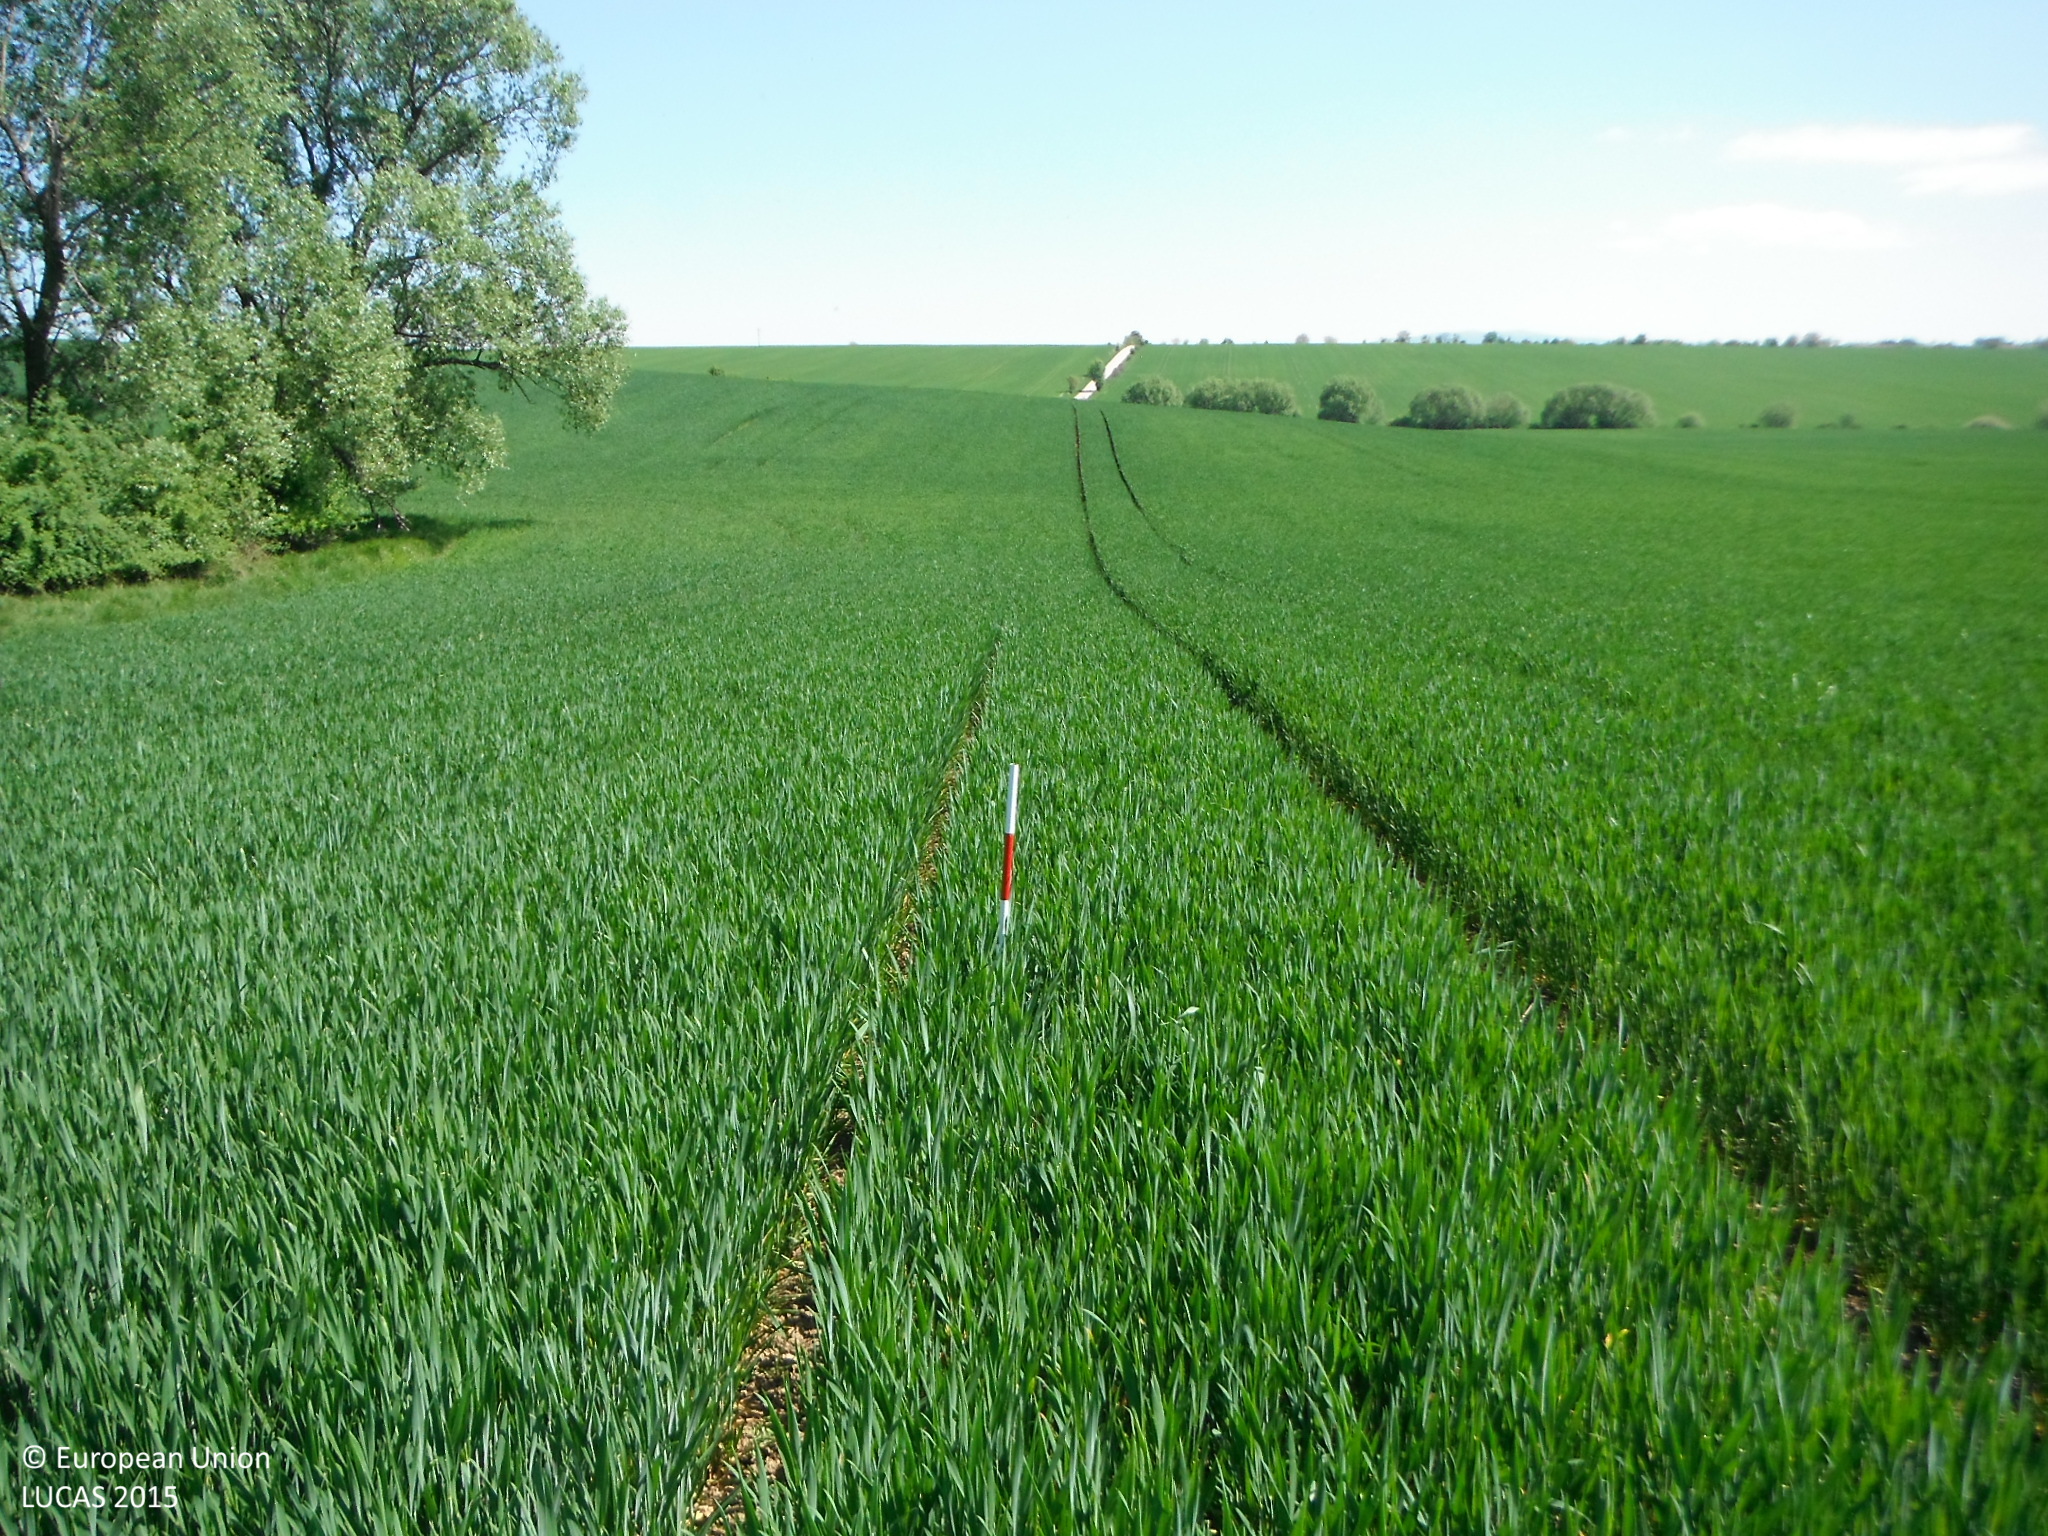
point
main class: Cropland
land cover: Common wheat
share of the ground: > 75 %
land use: Agriculture (excluding fallow land and kitchen gardens)
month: May
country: SK
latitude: 48.3136
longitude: 18.2265
